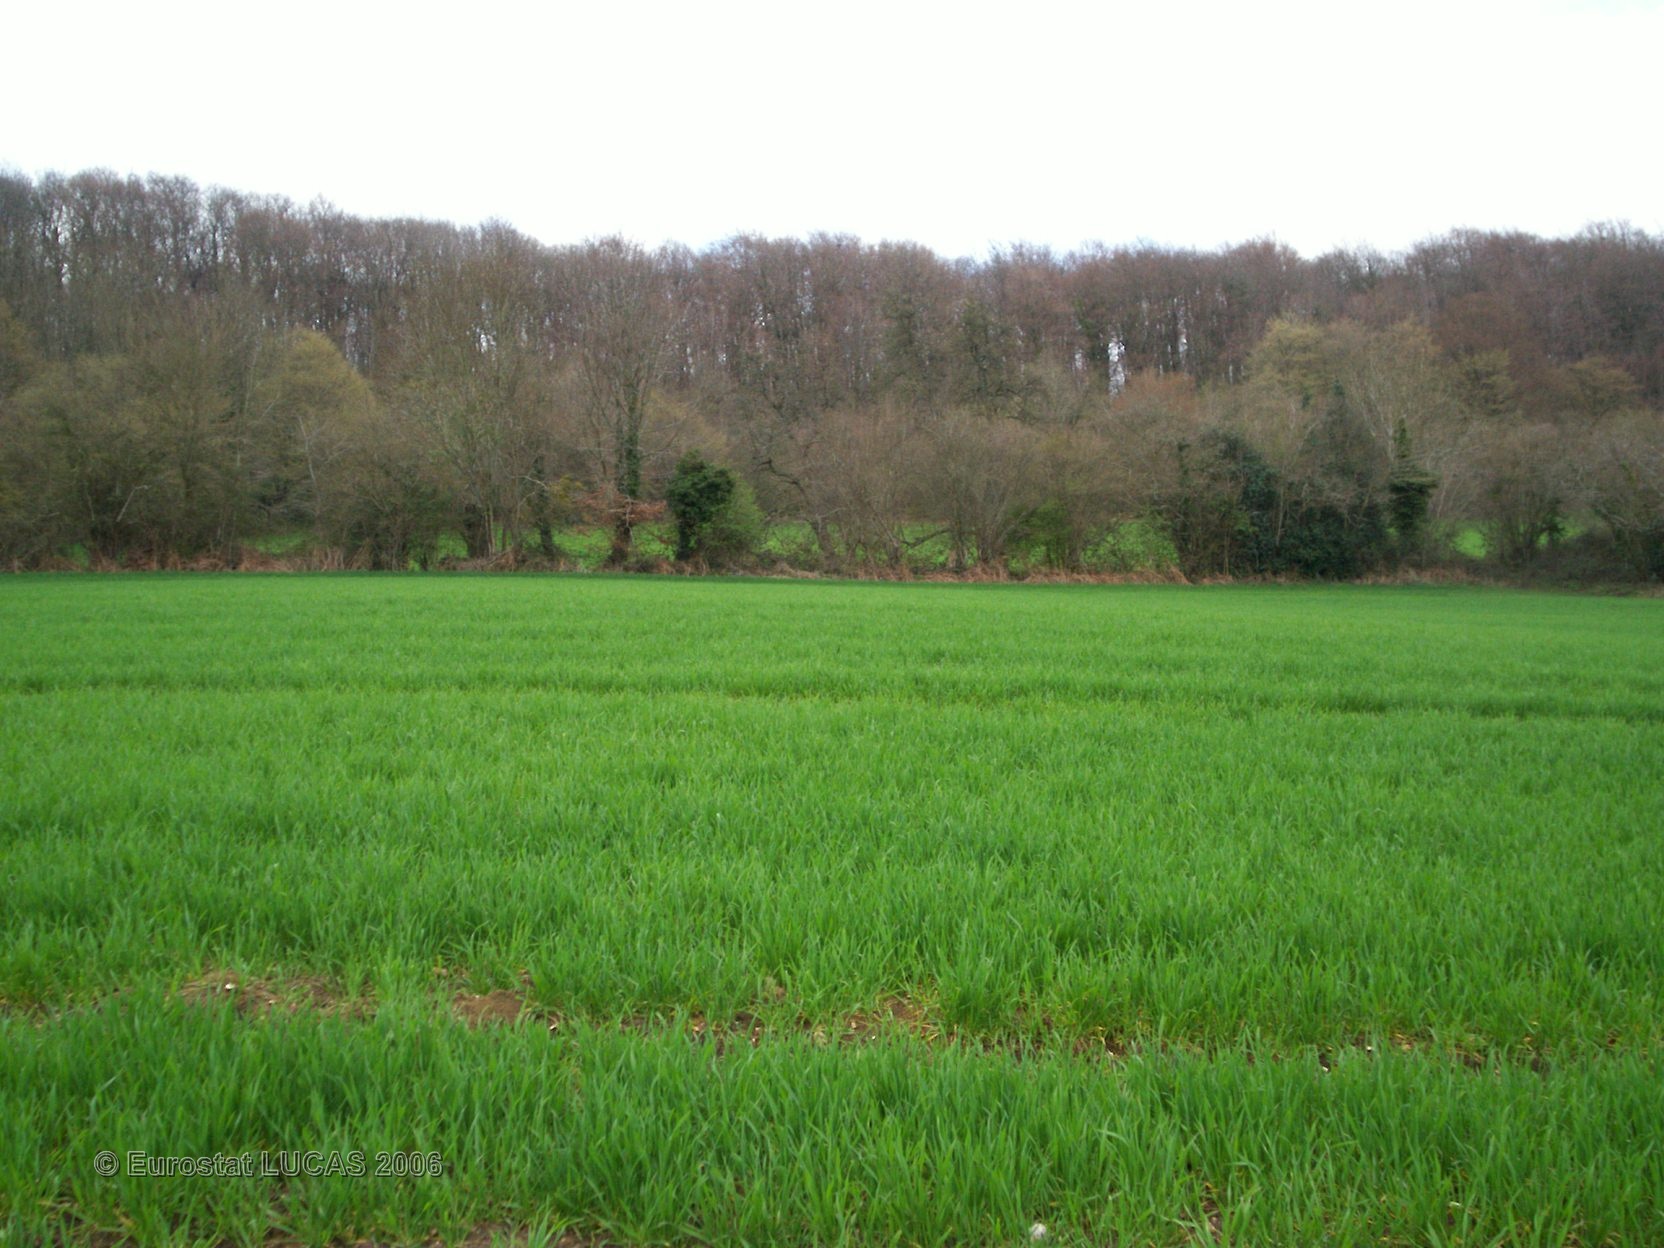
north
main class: Cropland
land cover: Common wheat
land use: Agriculture (excluding fallow land and kitchen gardens)
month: April
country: FR
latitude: 48.8811
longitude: 0.0840
